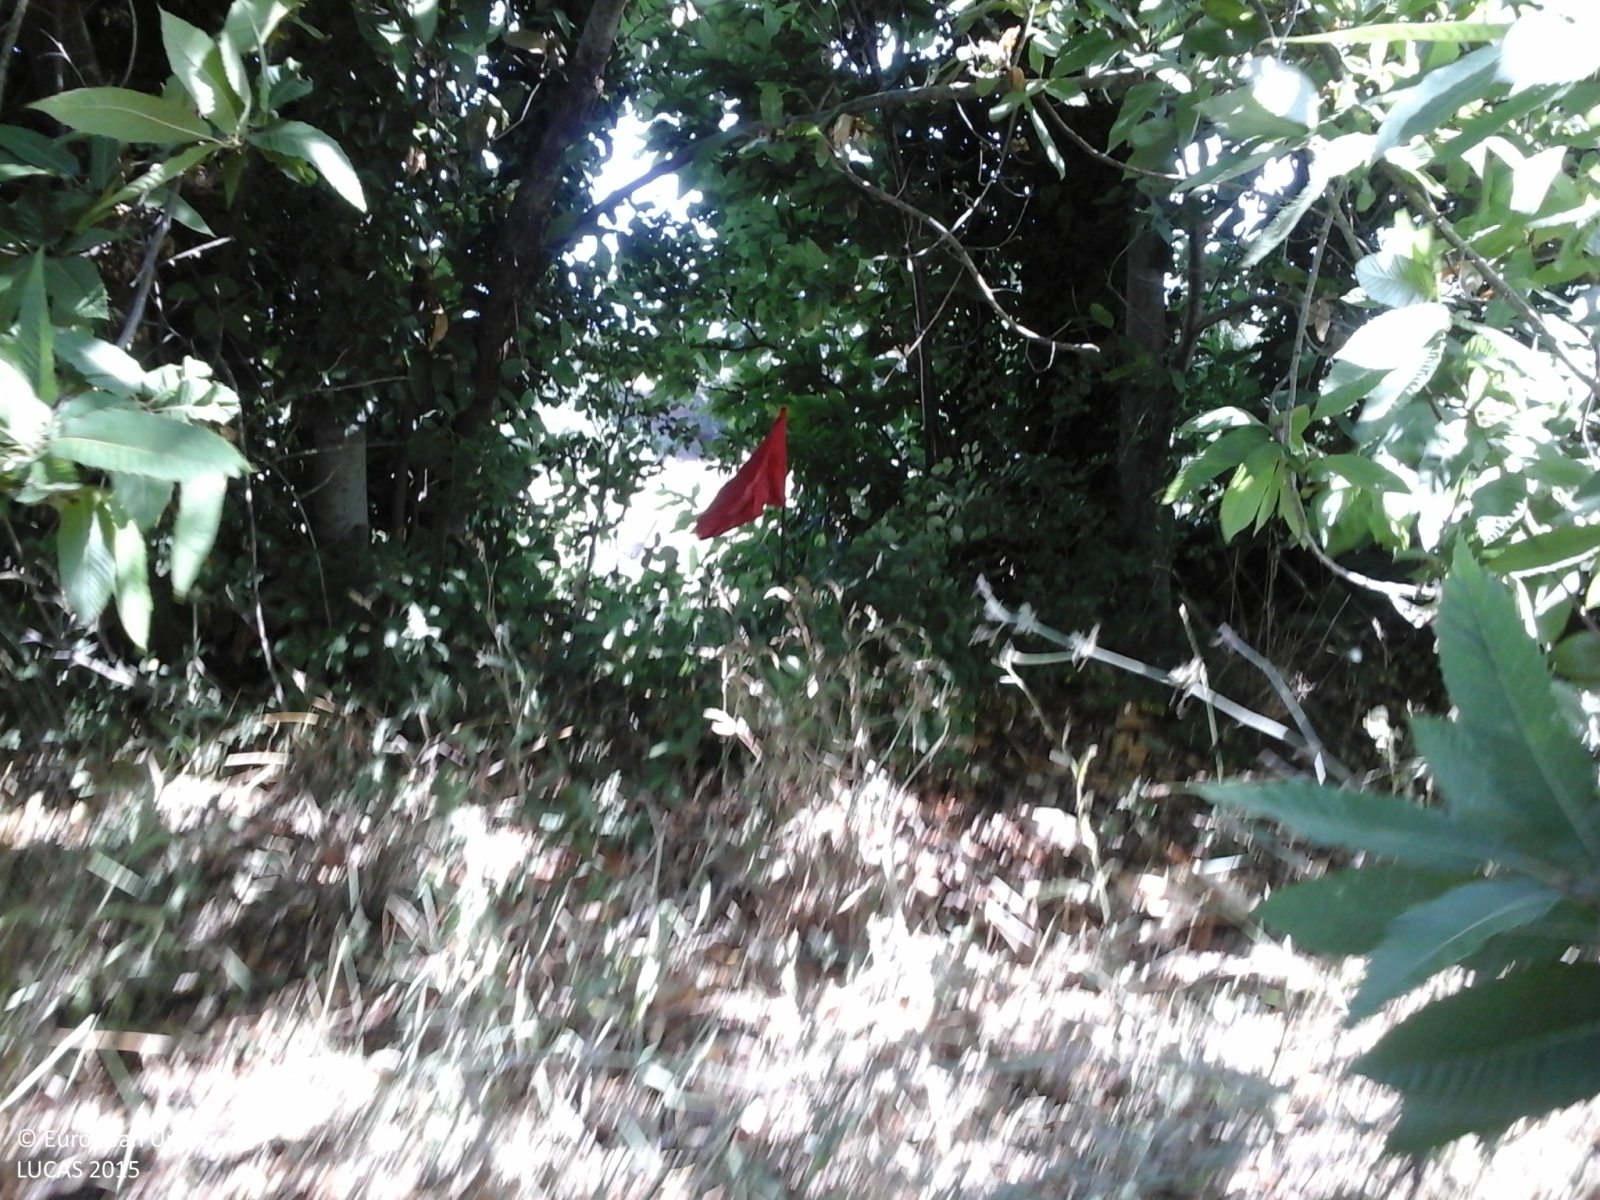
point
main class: Woodland
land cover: Broadleaved woodland
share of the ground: 50 - 75 %
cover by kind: broadleaved forest trees 60 %, shrubs 20 %, herbaceous plants 20 %
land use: Semi-natural and natural areas not in use
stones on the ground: < 10 %
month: August
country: IT
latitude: 42.6223
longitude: 11.6648
